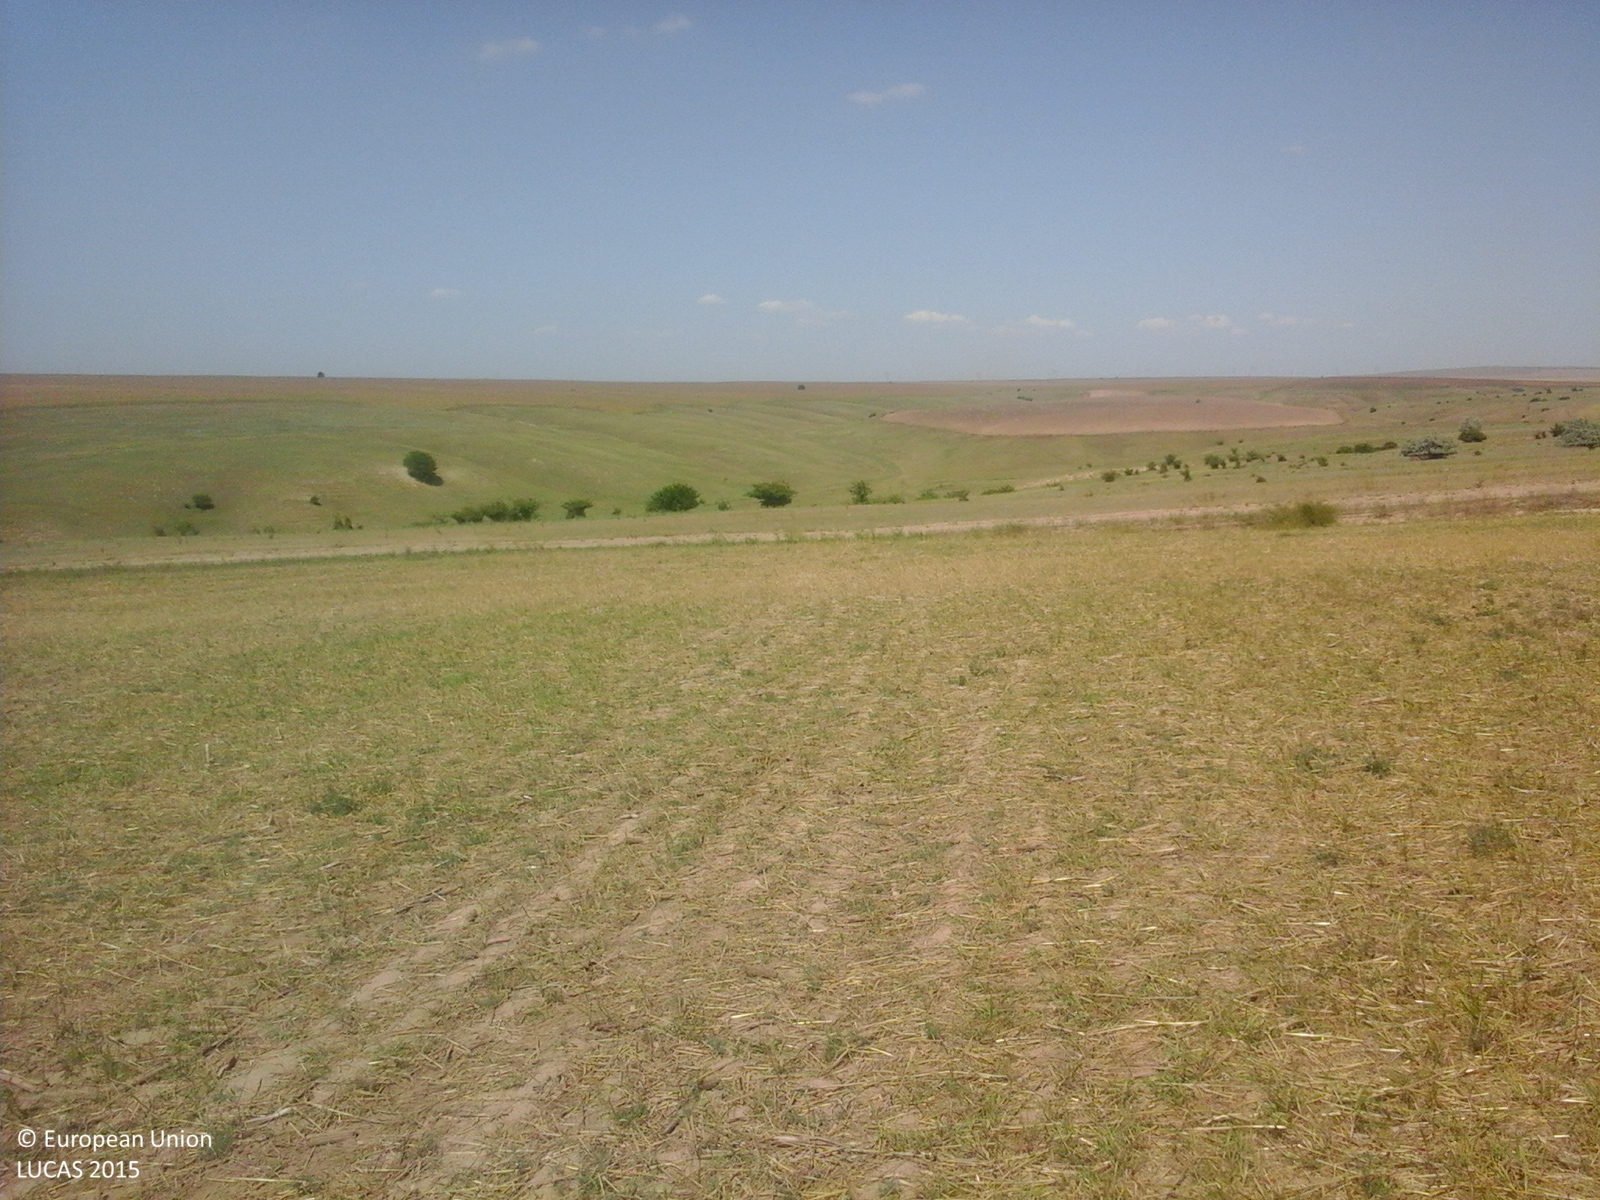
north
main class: Cropland
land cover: Common wheat
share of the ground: 10 - 25 %
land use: Agriculture (excluding fallow land and kitchen gardens)
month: August
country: RO
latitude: 44.4721
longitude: 28.1254
